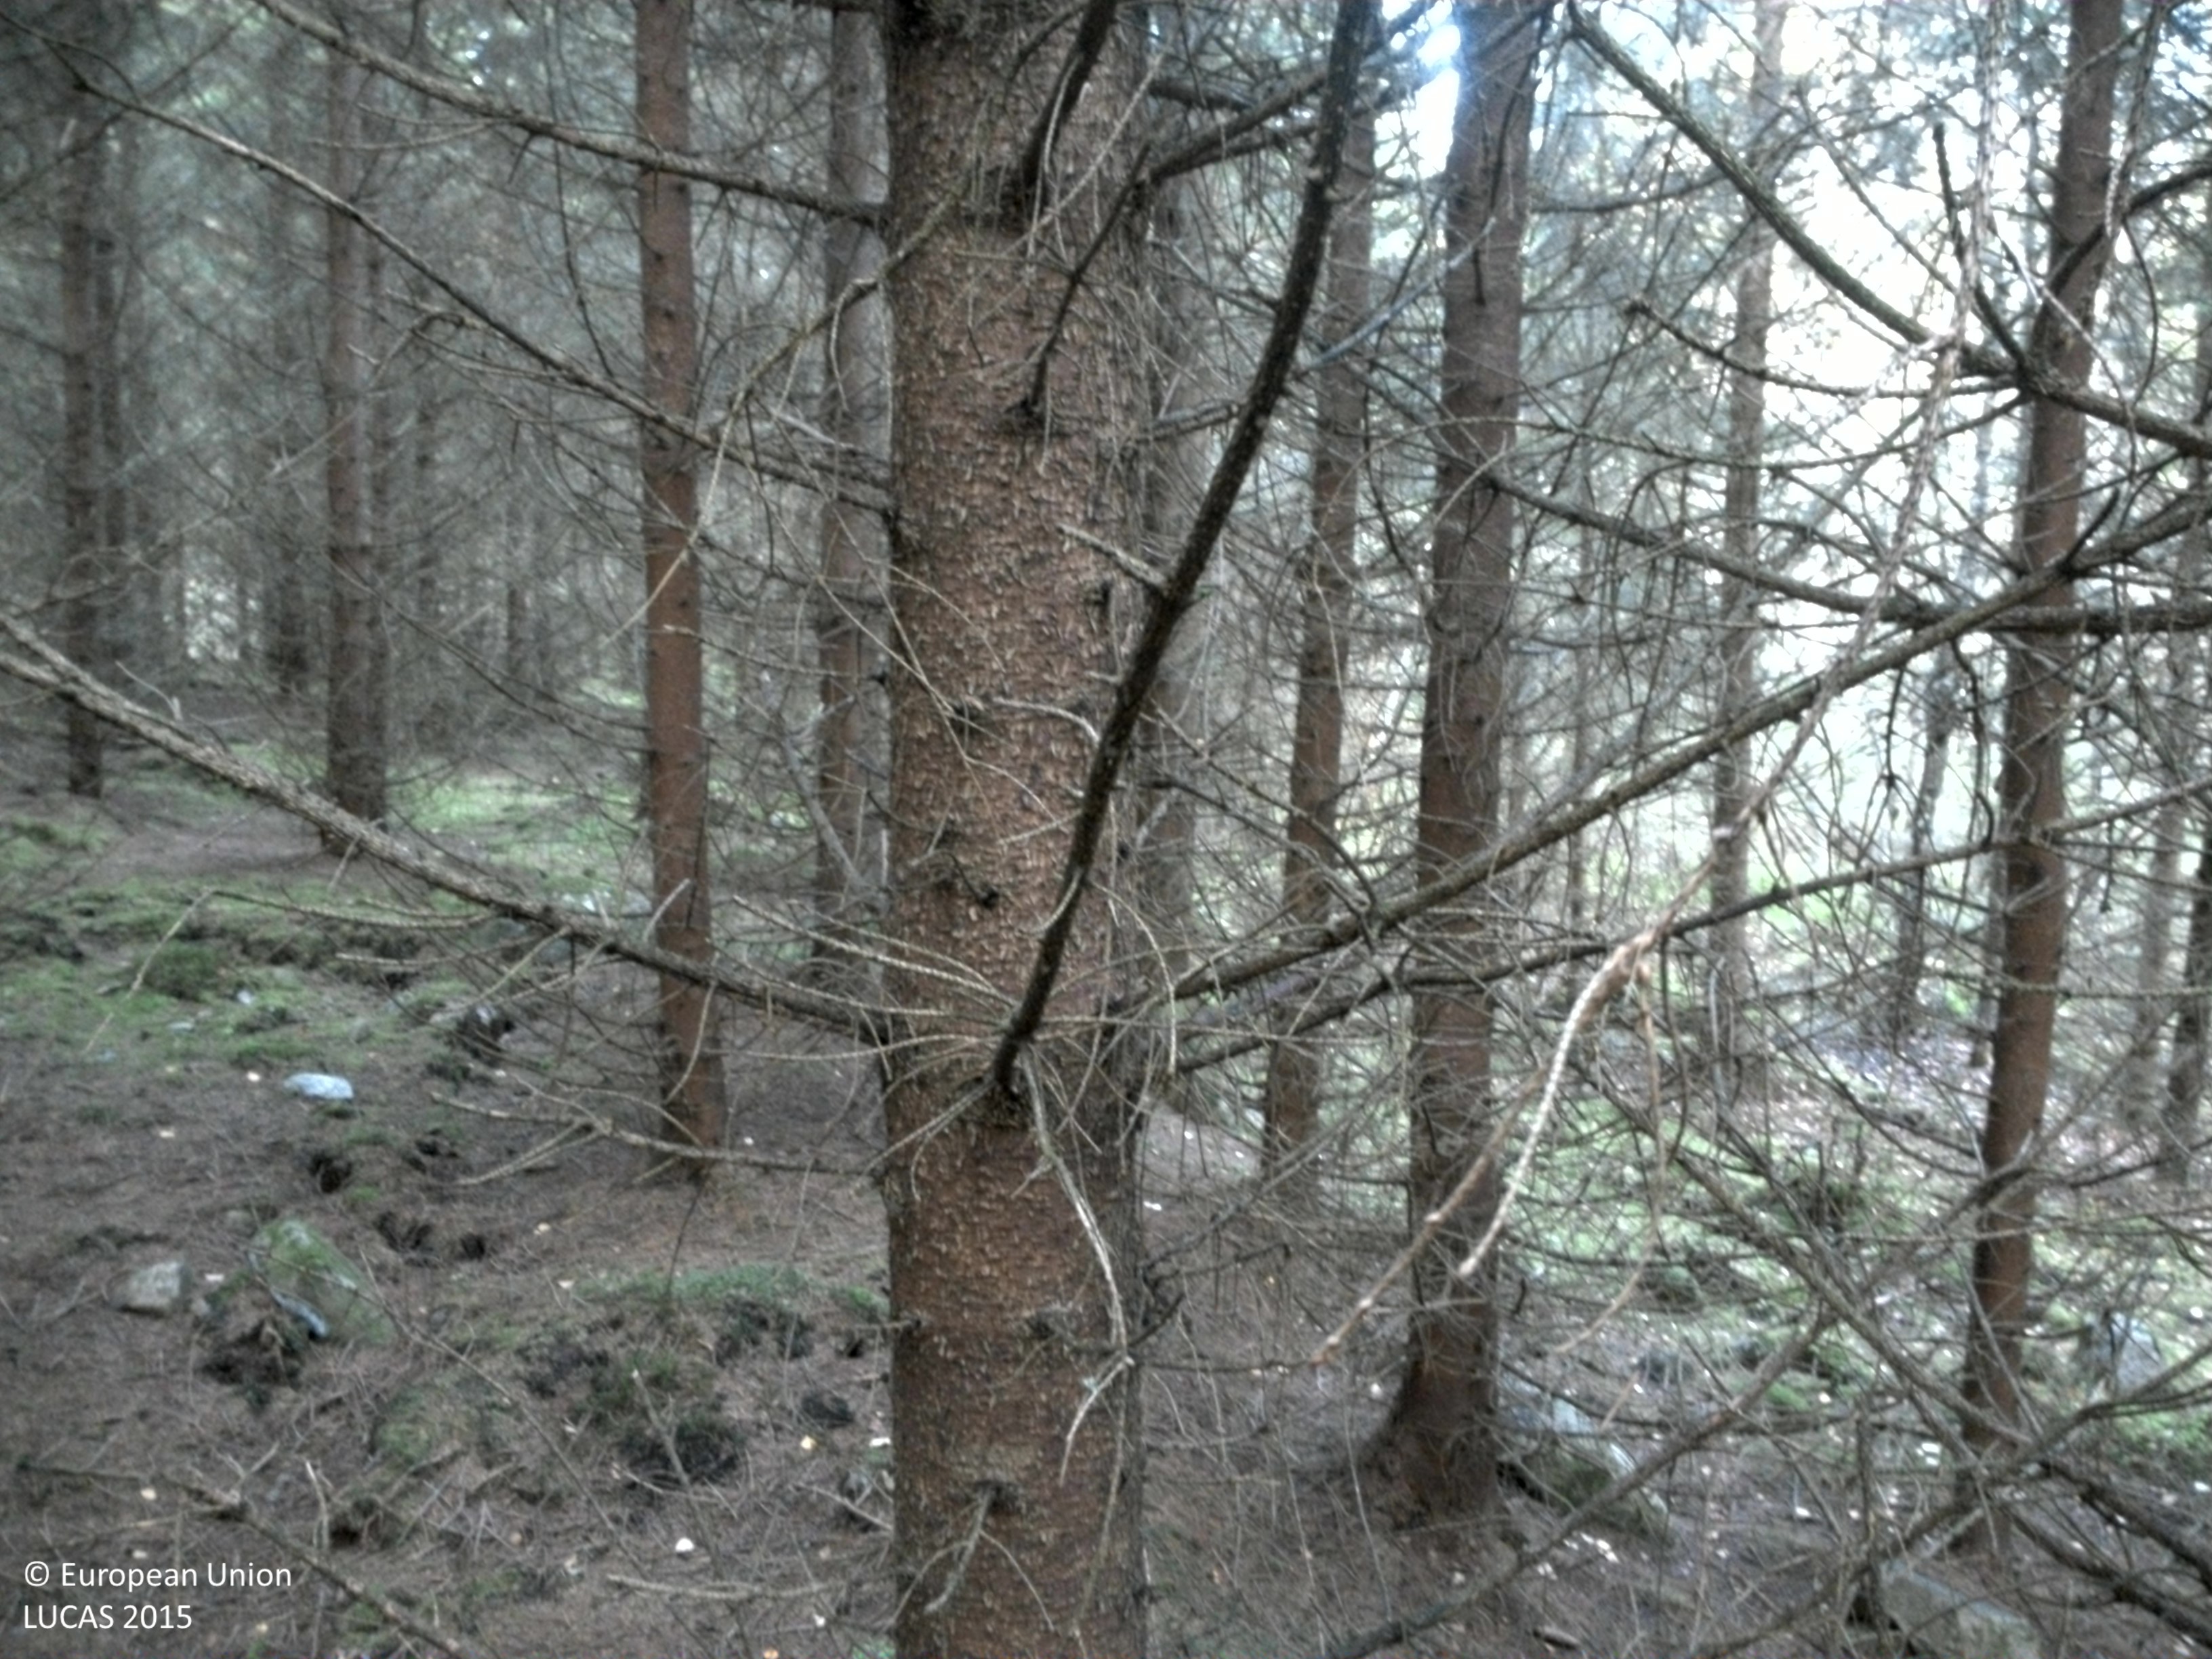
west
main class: Woodland
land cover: Spruce dominated coniferous woodland
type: boreal forest
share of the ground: > 75 %
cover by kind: coniferous forest trees 95 %, lichens and mosses 5 %
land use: Forestry
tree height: > 5 m
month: September
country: SE
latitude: 57.9102
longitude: 13.2523
